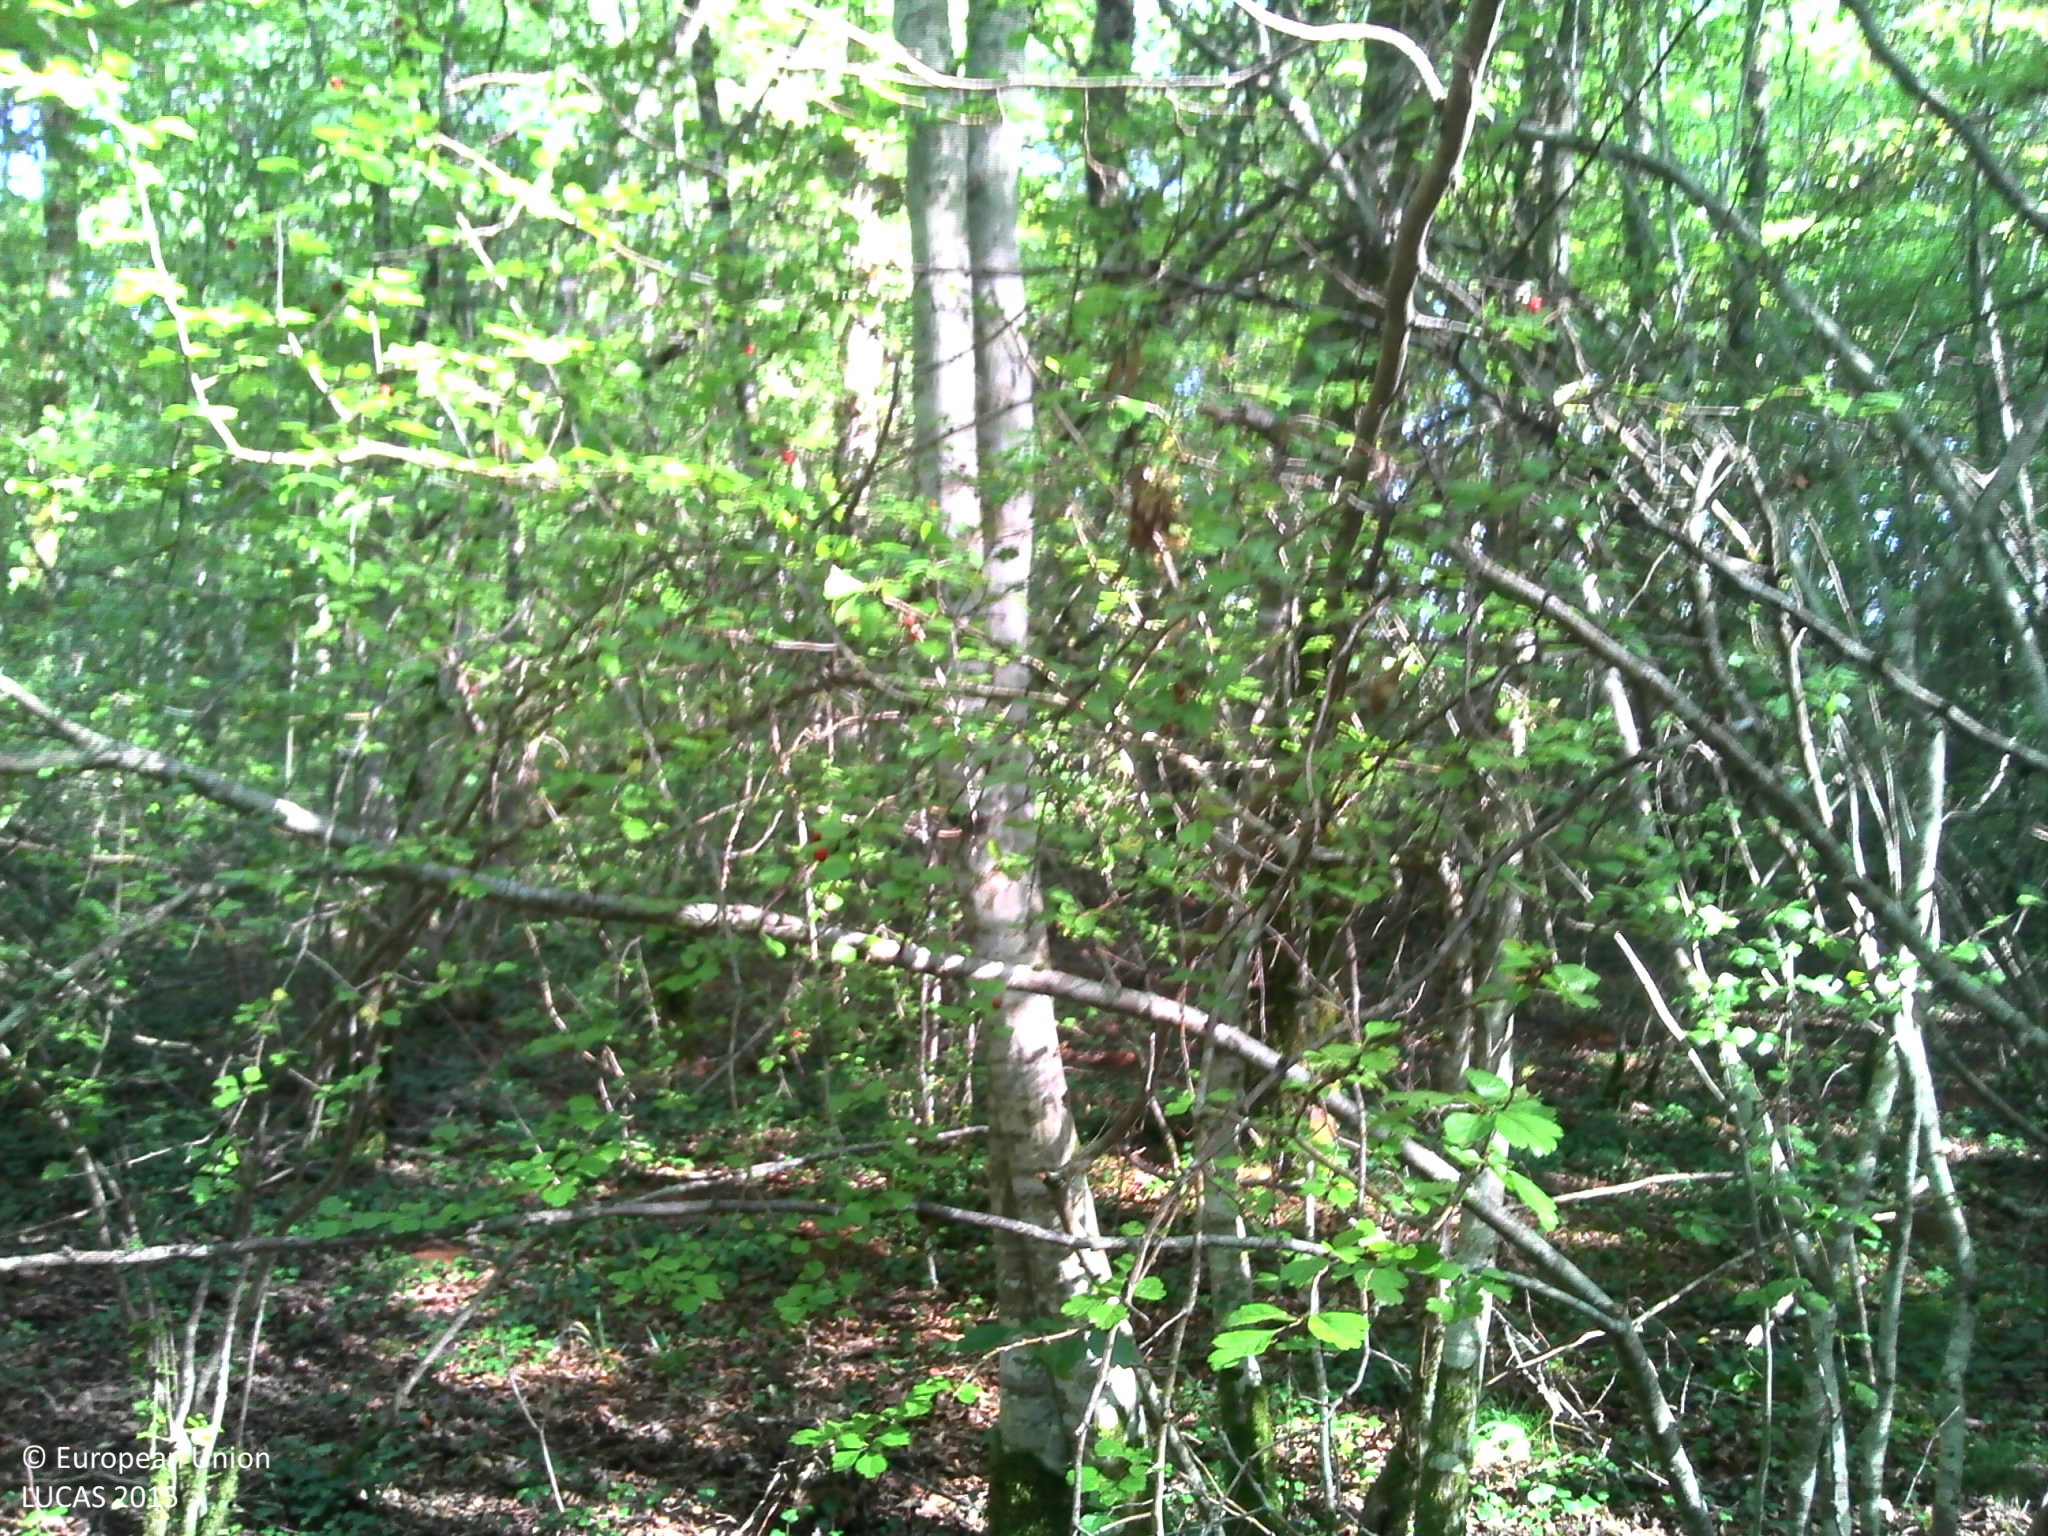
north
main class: Woodland
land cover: Broadleaved woodland
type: mesophytic deciduous forest
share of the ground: > 75 %
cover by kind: broadleaved forest trees 80 %, shrubs 10 %, herbaceous plants 10 %
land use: Forestry
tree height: > 5 m
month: August
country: FR
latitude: 47.2010
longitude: 4.8389
